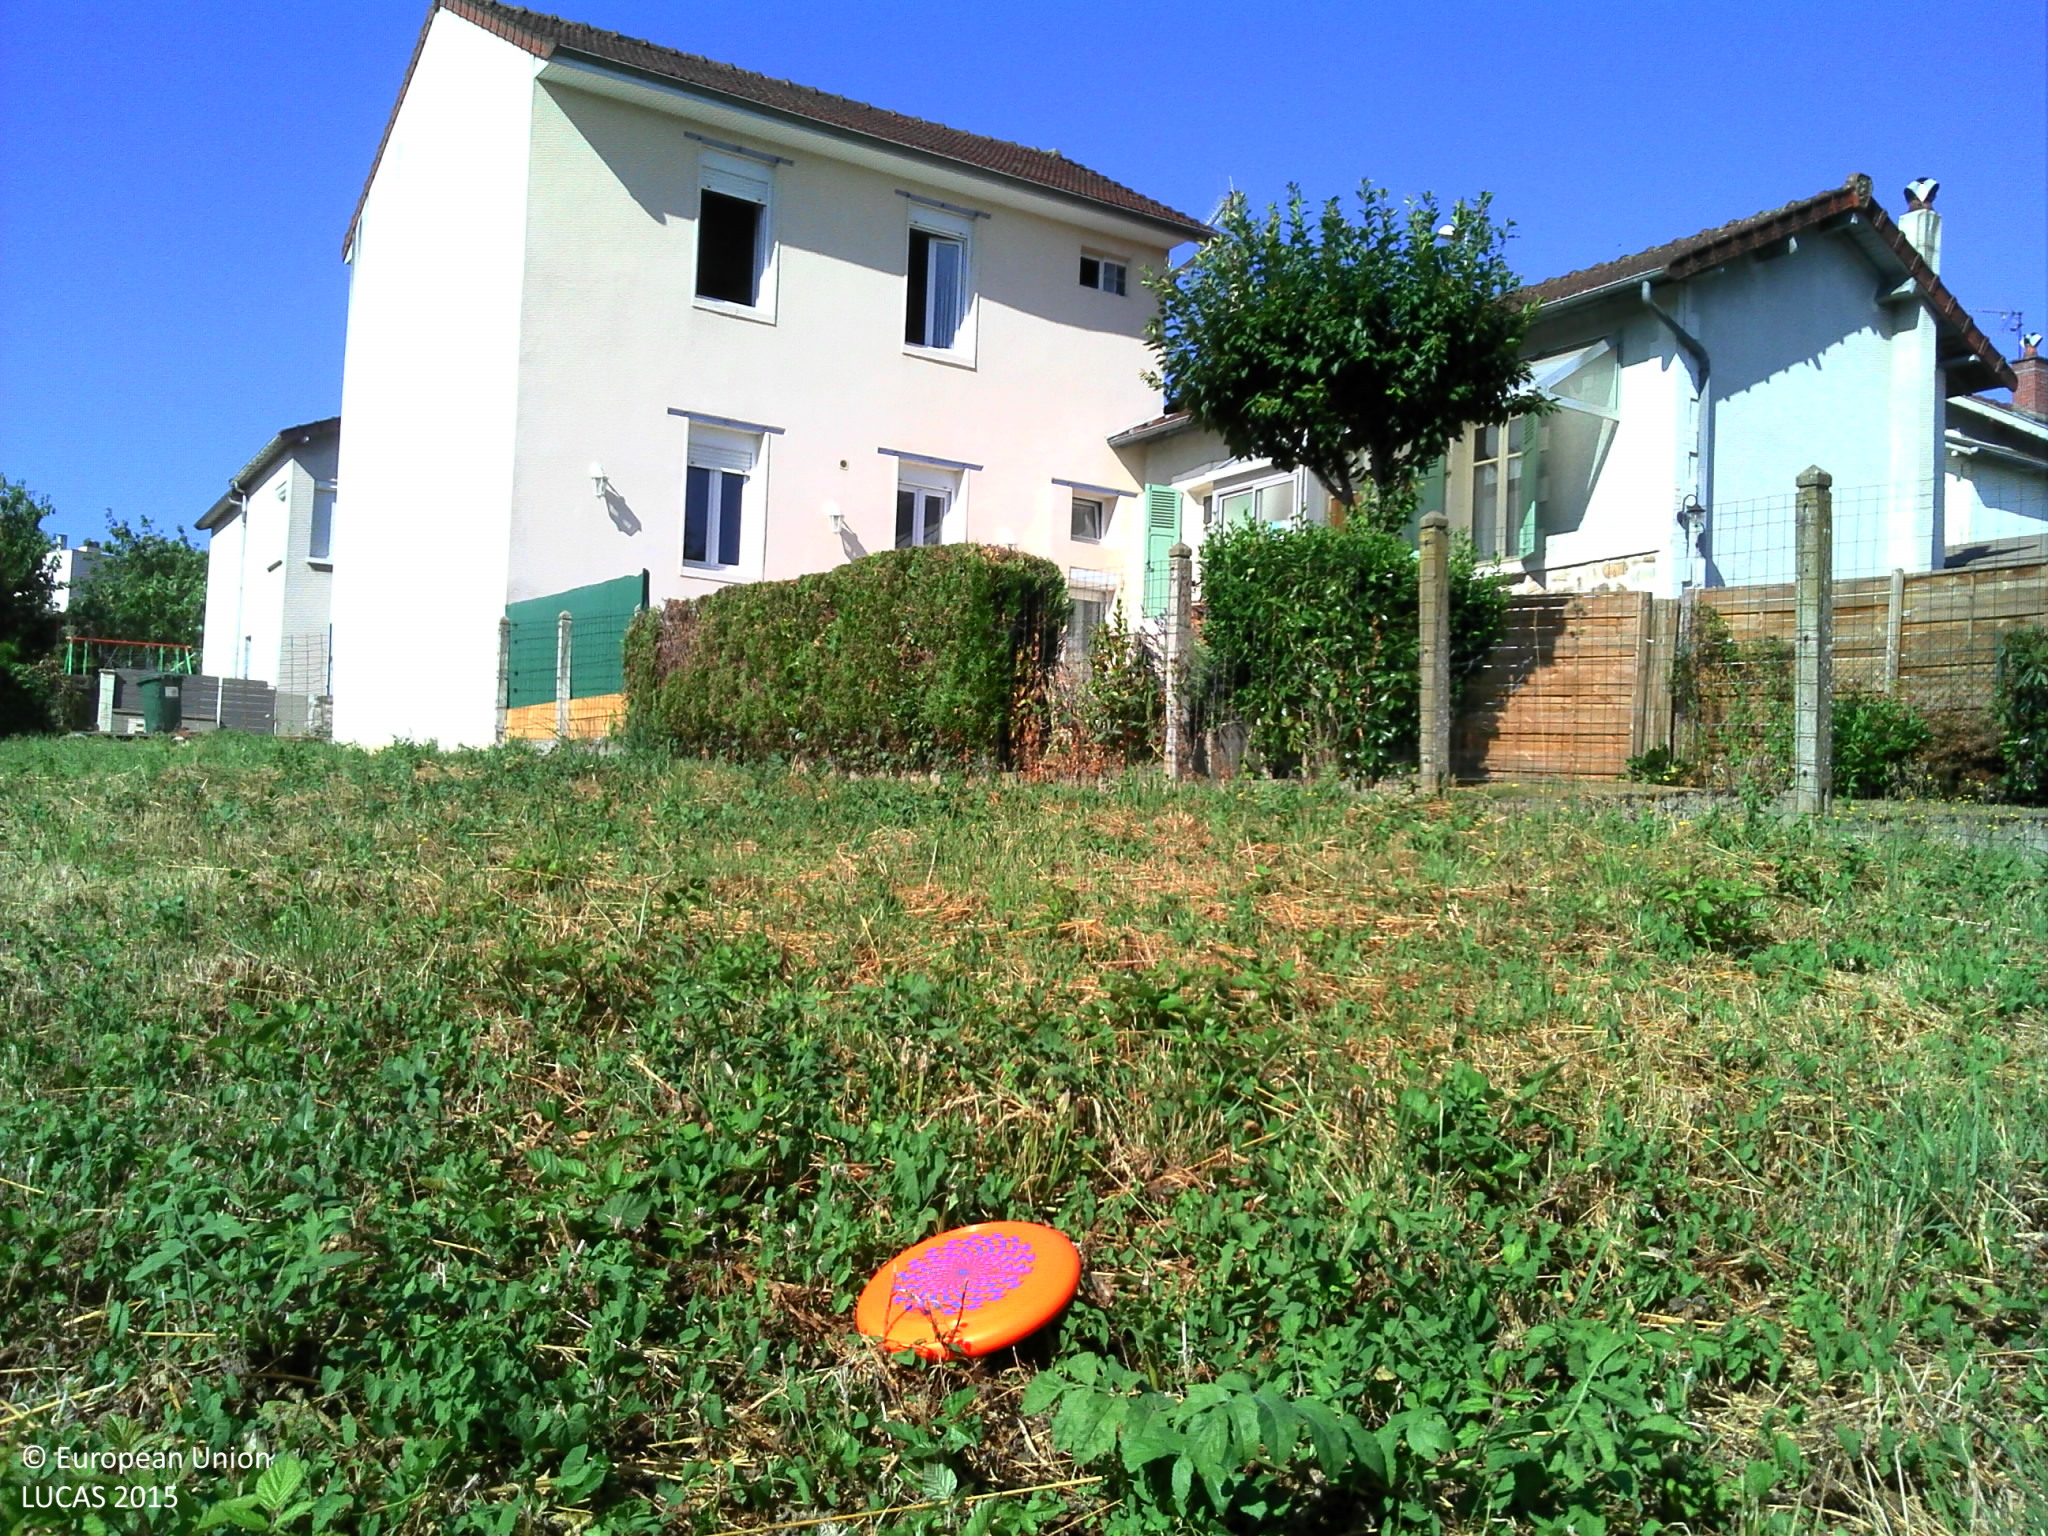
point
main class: Grassland
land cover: Grassland with sparse tree/shrub cover
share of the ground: > 75 %
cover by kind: herbaceous plants 90 %, broadleaved forest trees 5 %
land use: Residential
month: July
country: FR
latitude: 45.8490
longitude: 1.2728
